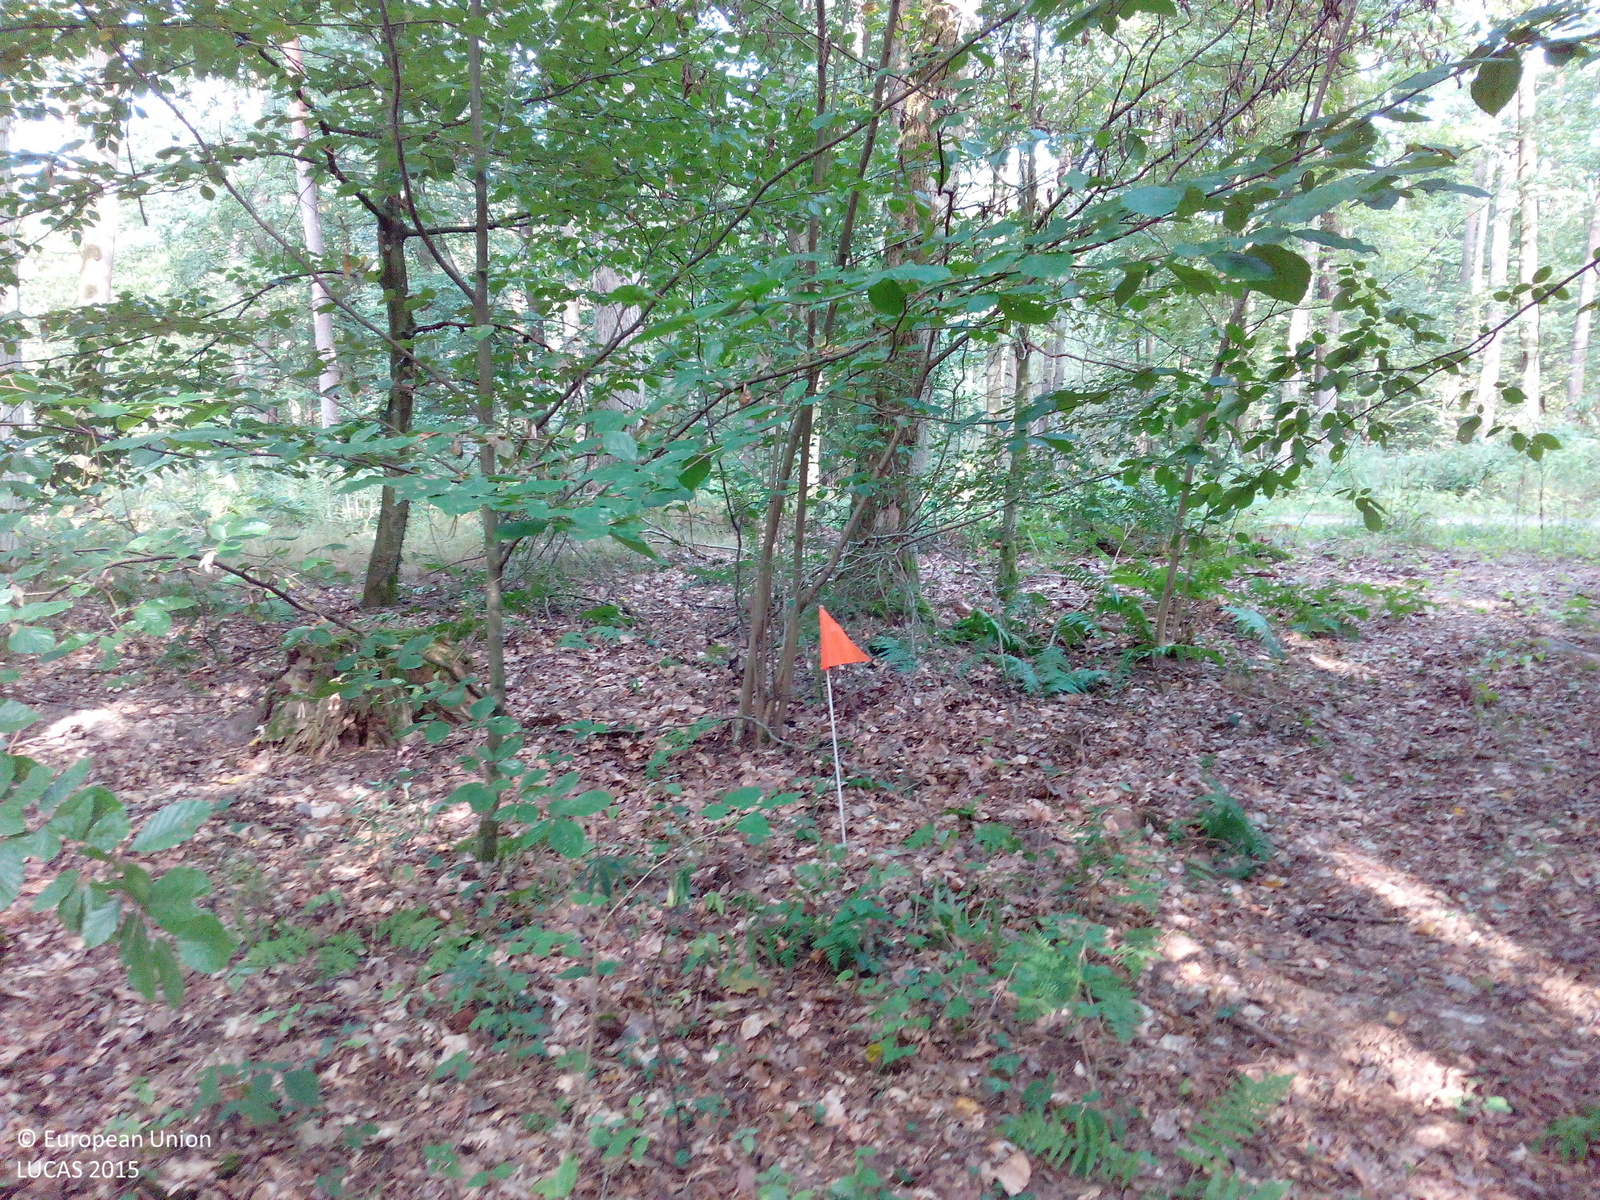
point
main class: Woodland
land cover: Pine dominated mixed woodland
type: hemiboreal forest and nemoral coniferous forest and mixed broadleaved-coniferous forest
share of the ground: > 75 %
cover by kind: broadleaved forest trees 55 %, coniferous forest trees 40 %, herbaceous plants 5 %
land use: Forestry
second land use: Amenities, museums, leisure
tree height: > 5 m
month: September
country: DE
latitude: 49.7878
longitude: 9.5696
